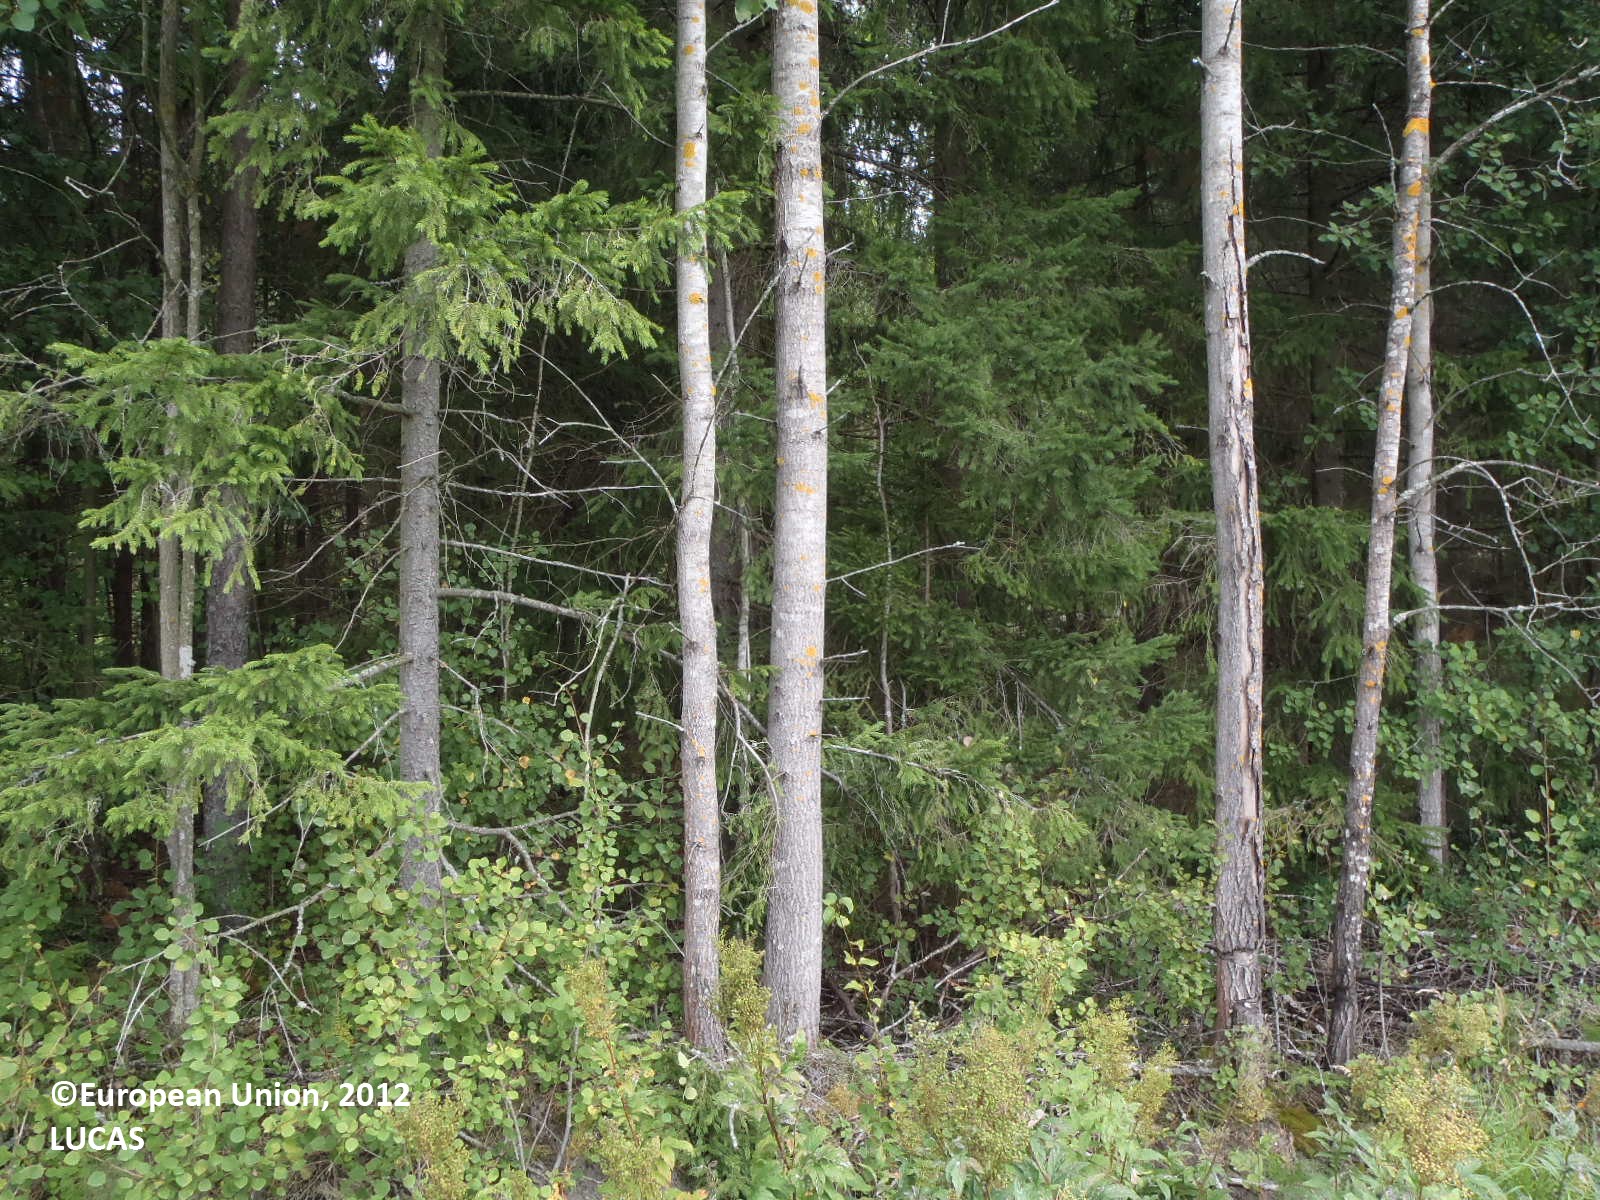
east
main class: Cropland
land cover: Barley
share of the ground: > 75 %
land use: Agriculture (excluding fallow land and kitchen gardens)
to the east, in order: Barley; Grass margins; Ditches and canals; Spruce dominated coniferous woodland; Ditches and canals; Grass margins; Paved roads, cycling and walking lanes; Grass margins; Ditches and canals; Pine dominated coniferous woodland
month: August
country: FI
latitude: 60.5617
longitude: 22.1951
